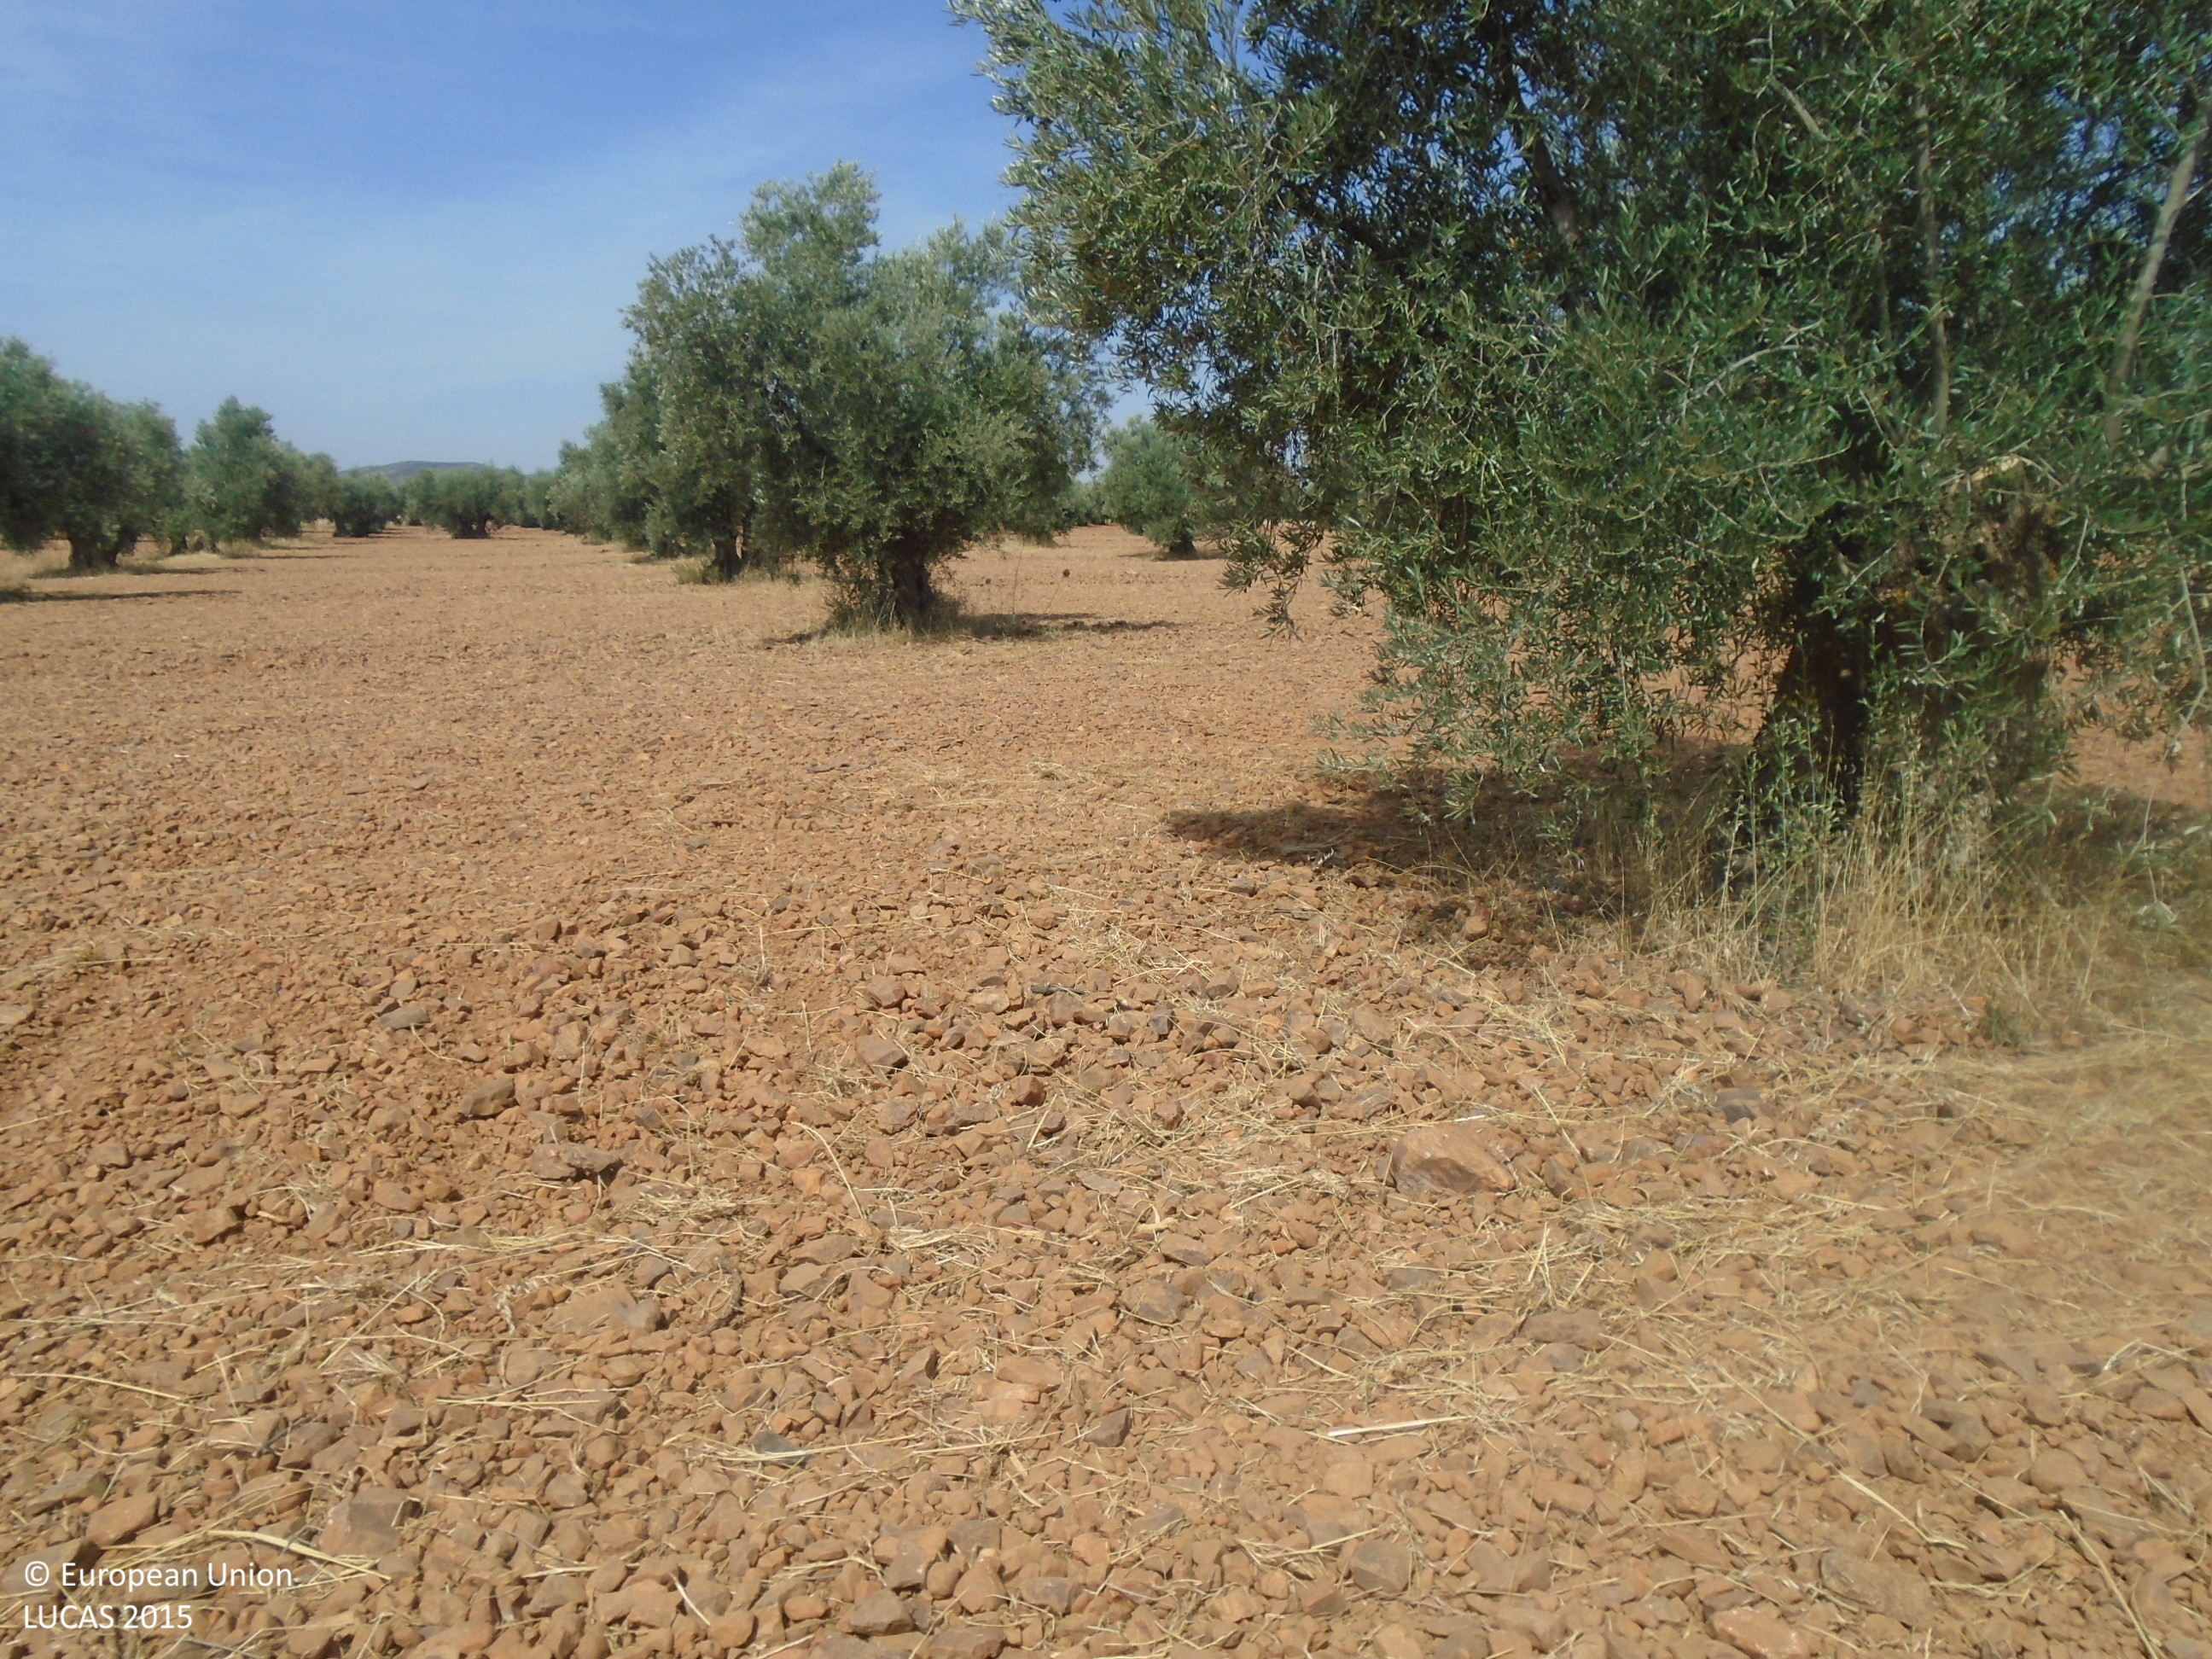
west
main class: Cropland
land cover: Olive groves
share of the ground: 25 - 50 %
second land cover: Other bare soil
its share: > 75 %
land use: Agriculture (excluding fallow land and kitchen gardens)
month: July
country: ES
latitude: 39.3927
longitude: -3.5722
